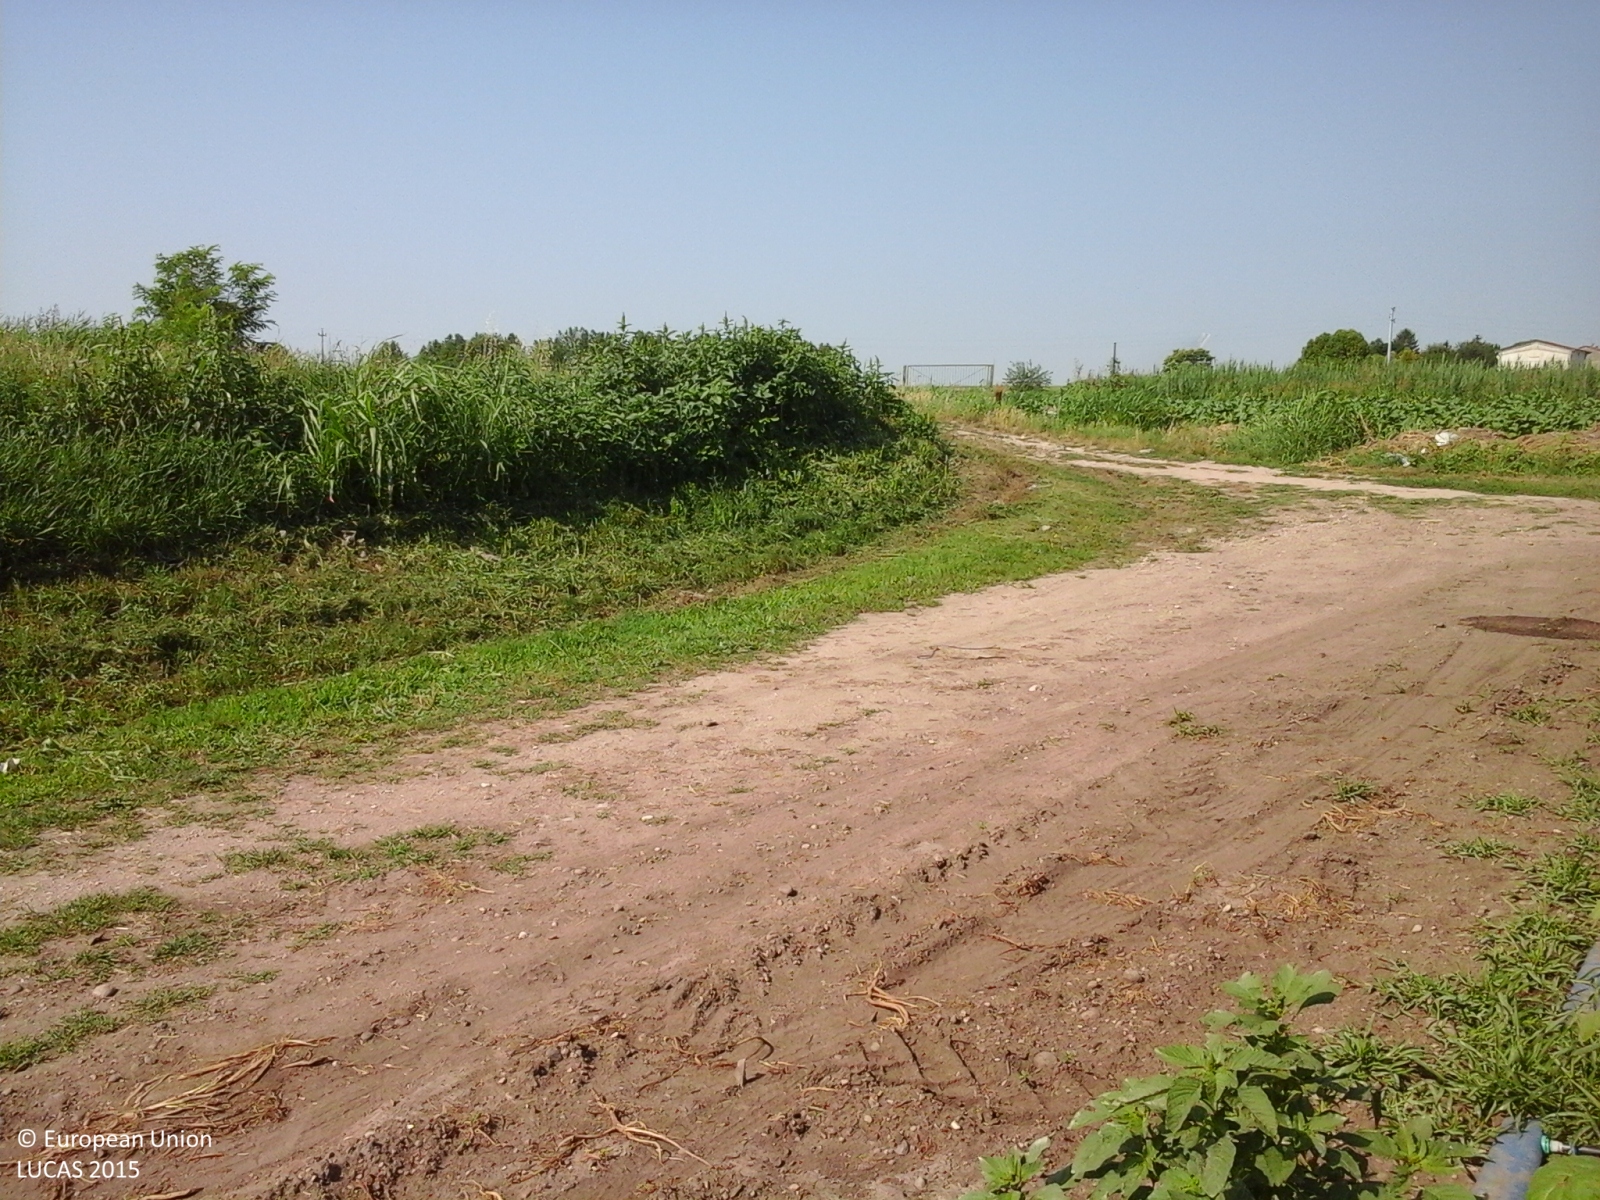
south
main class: Cropland
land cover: Tobacco
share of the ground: > 75 %
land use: Agriculture (excluding fallow land and kitchen gardens)
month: July
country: IT
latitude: 45.3191
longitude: 11.0315
